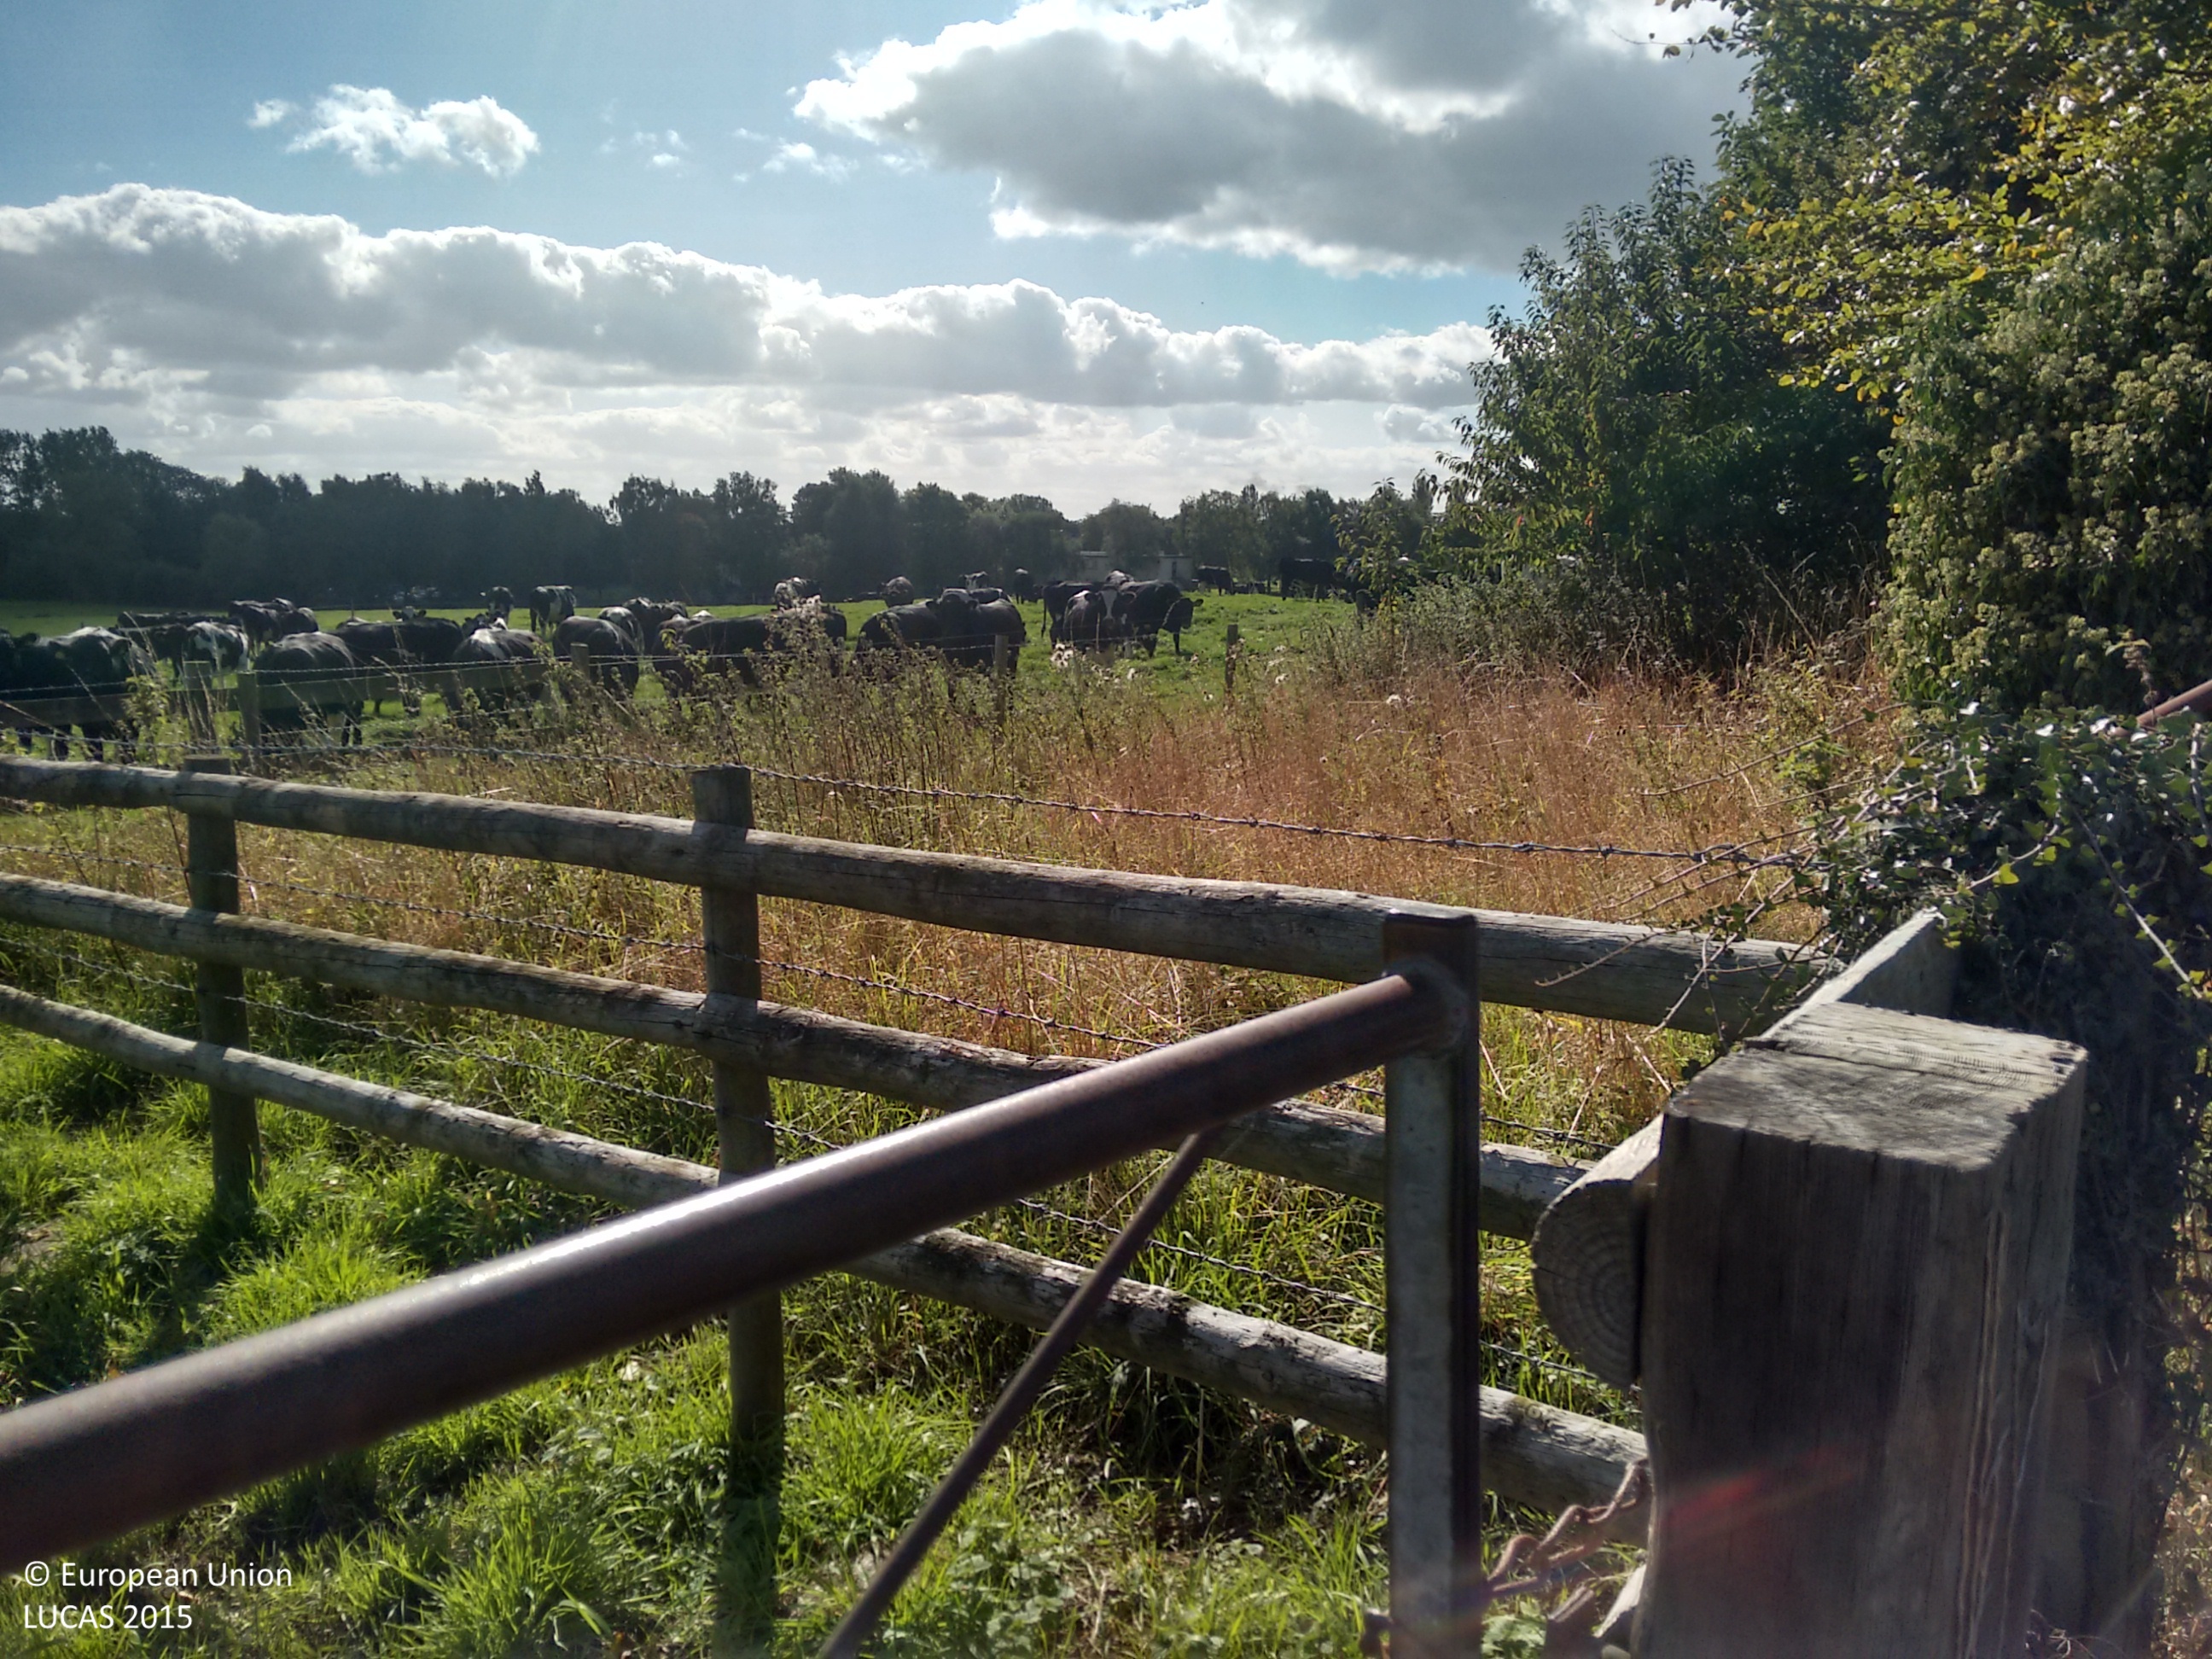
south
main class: Grassland
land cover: Grassland without tree/shrub cover
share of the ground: > 75 %
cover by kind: herbaceous plants 100 %
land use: Agriculture (excluding fallow land and kitchen gardens)
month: September
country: GB
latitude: 52.8292
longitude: -2.0965
